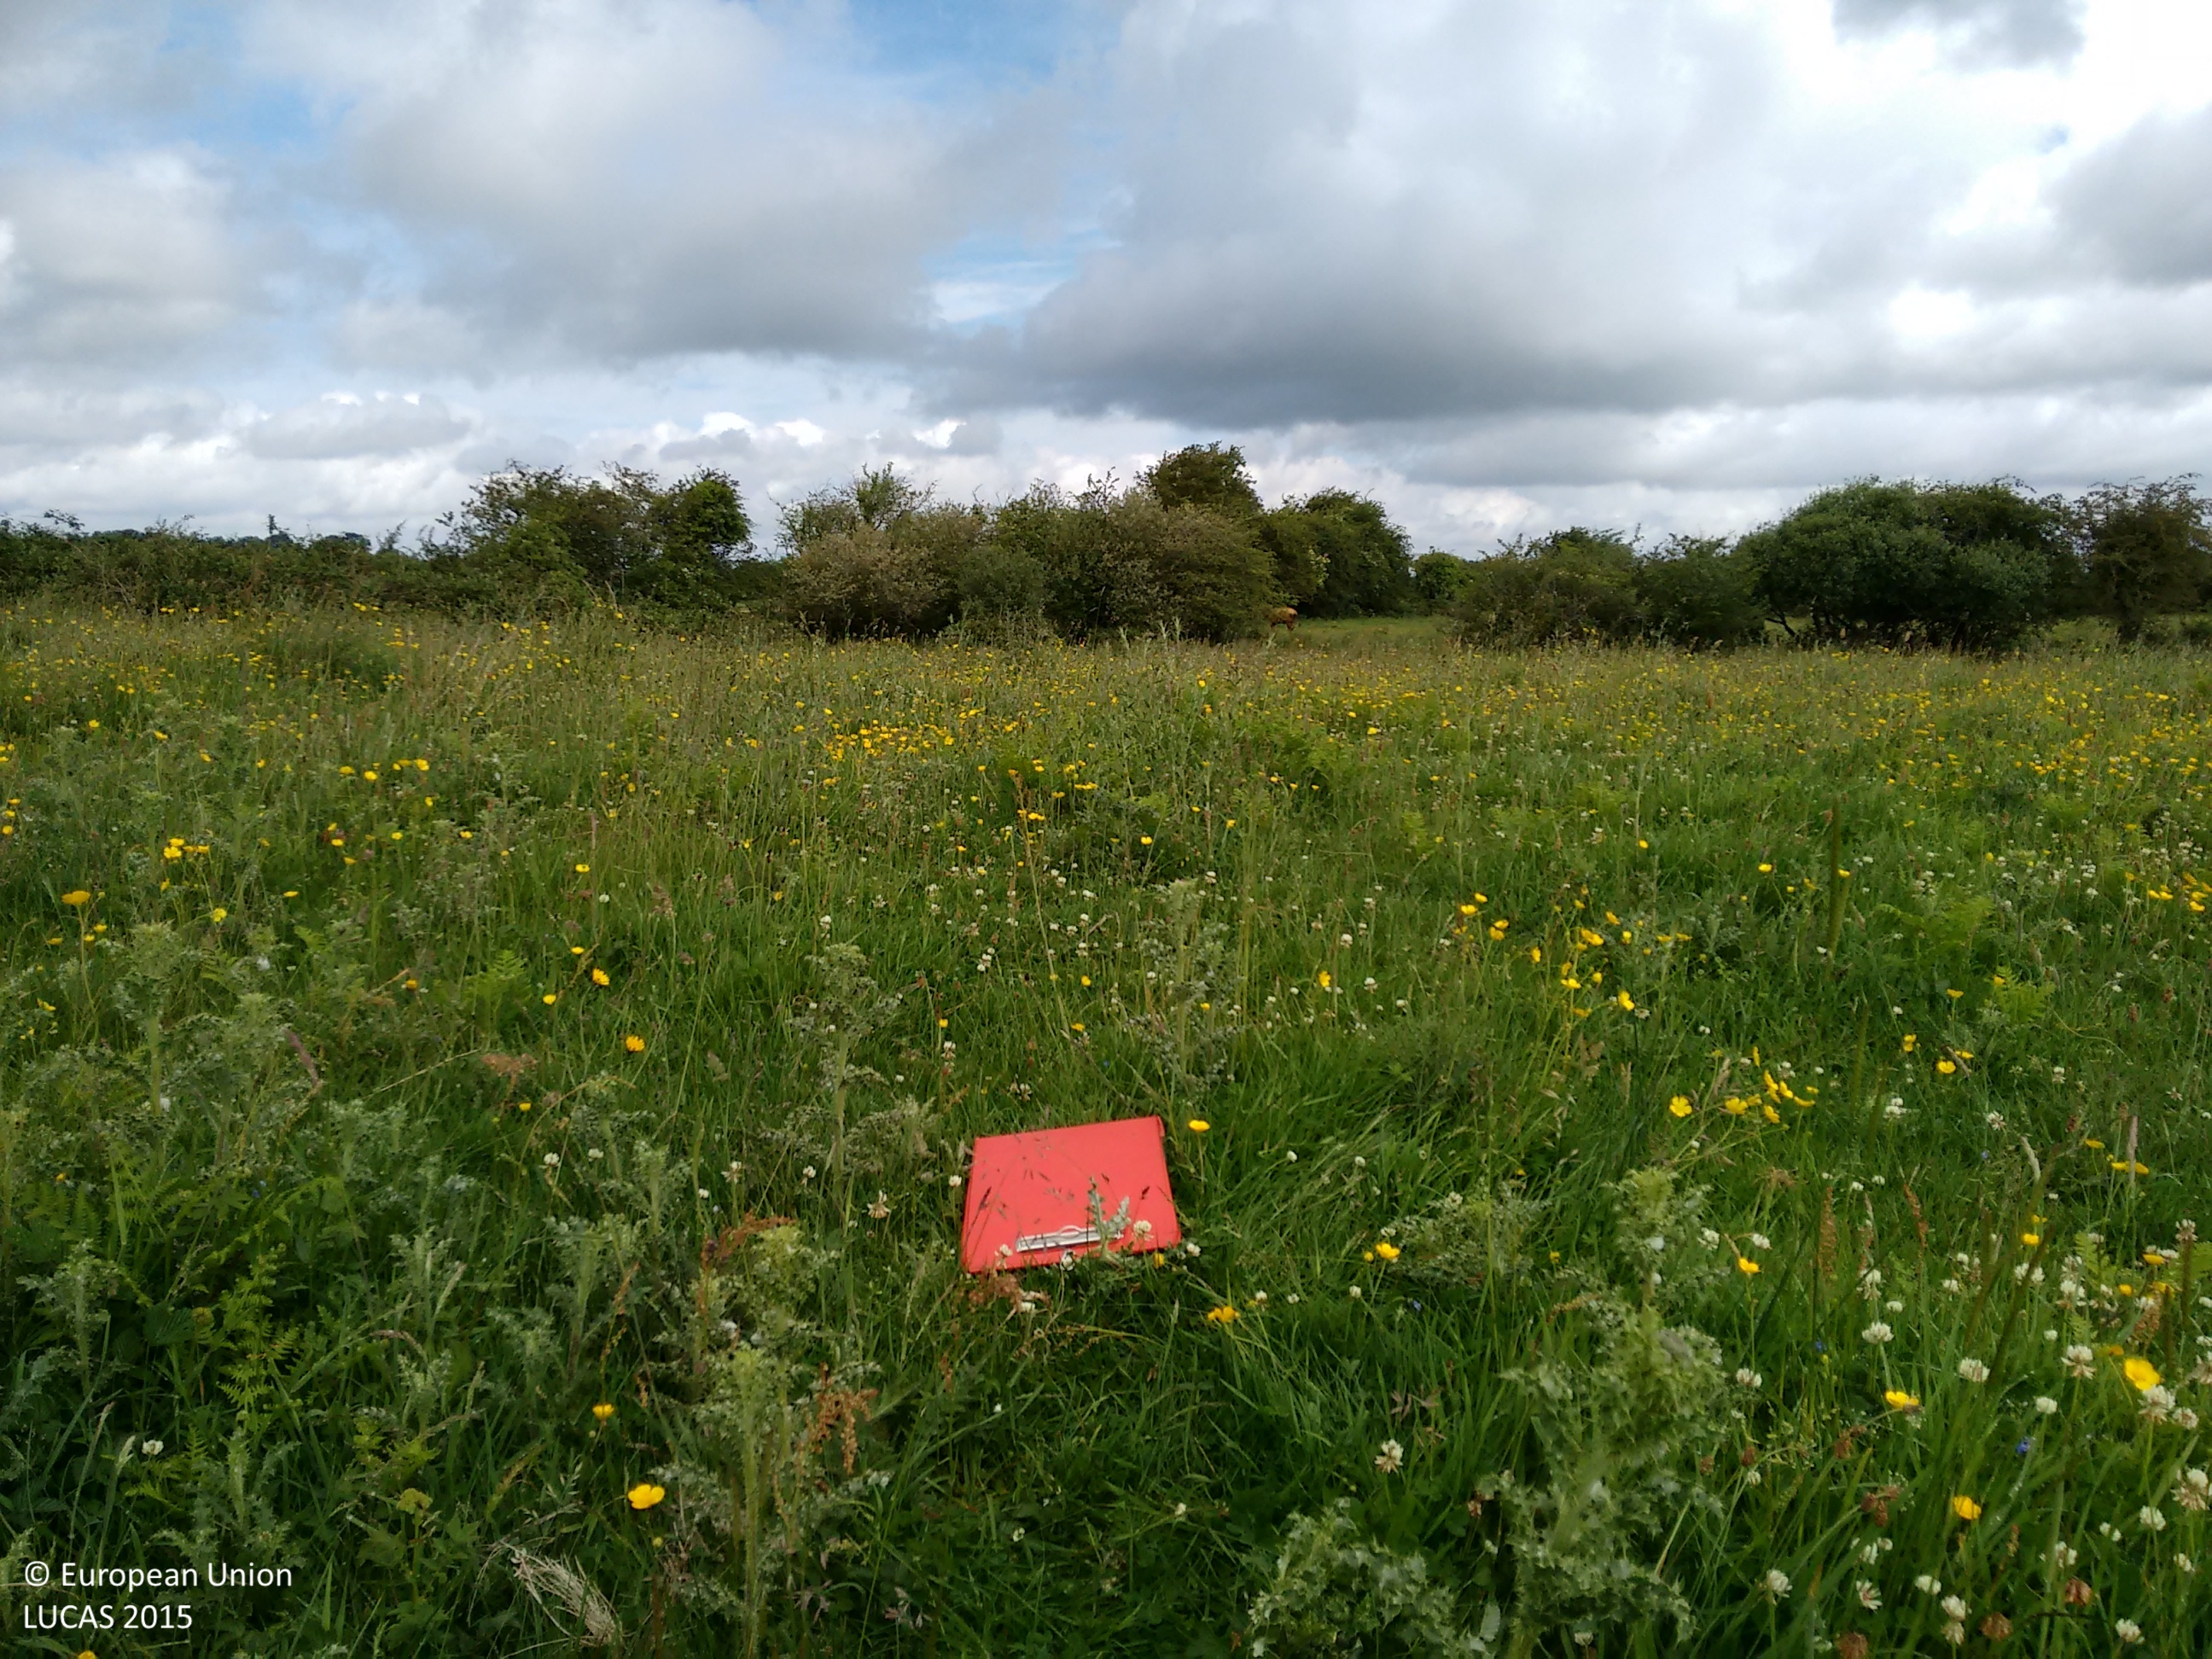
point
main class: Grassland
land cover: Grassland without tree/shrub cover
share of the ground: > 75 %
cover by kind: herbaceous plants 95 %, shrubs 5 %
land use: Agriculture (excluding fallow land and kitchen gardens)
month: June
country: IE
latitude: 53.6474
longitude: -6.8222
